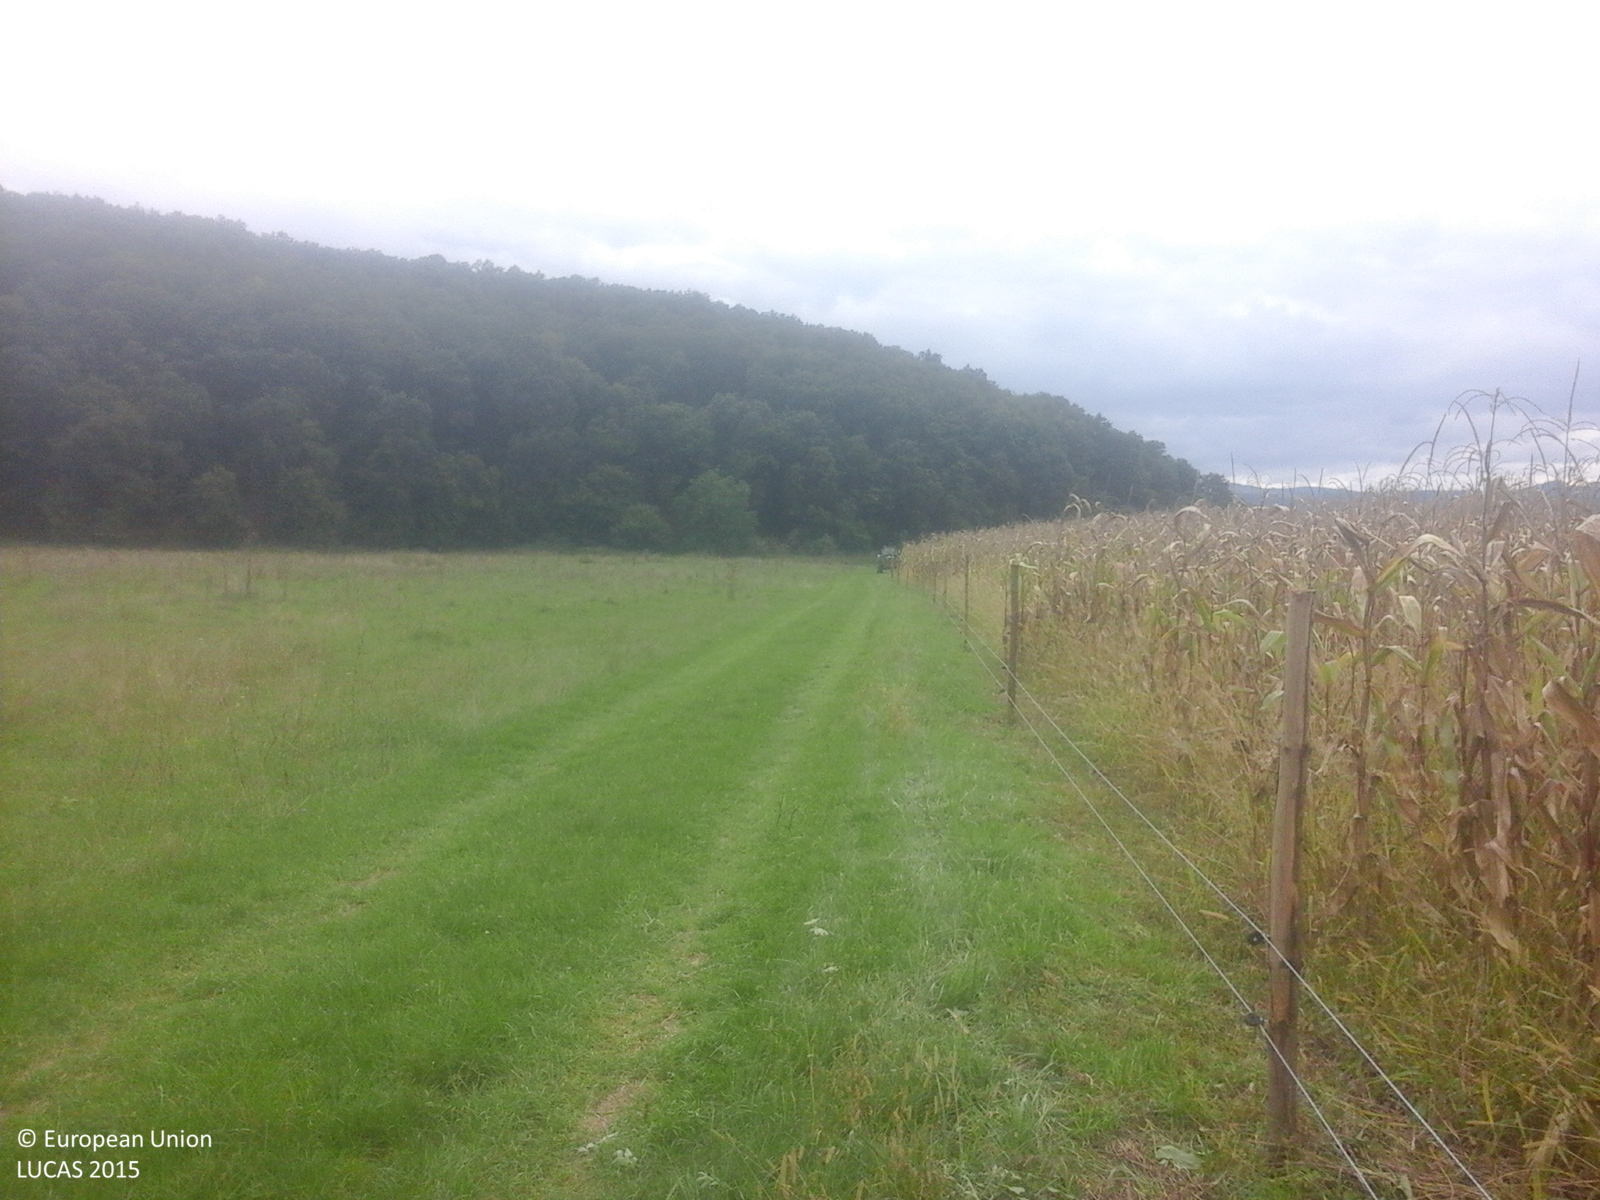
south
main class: Cropland
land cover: Maize
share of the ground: > 75 %
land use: Agriculture (excluding fallow land and kitchen gardens)
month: September
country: RO
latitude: 45.8597
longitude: 23.8906
